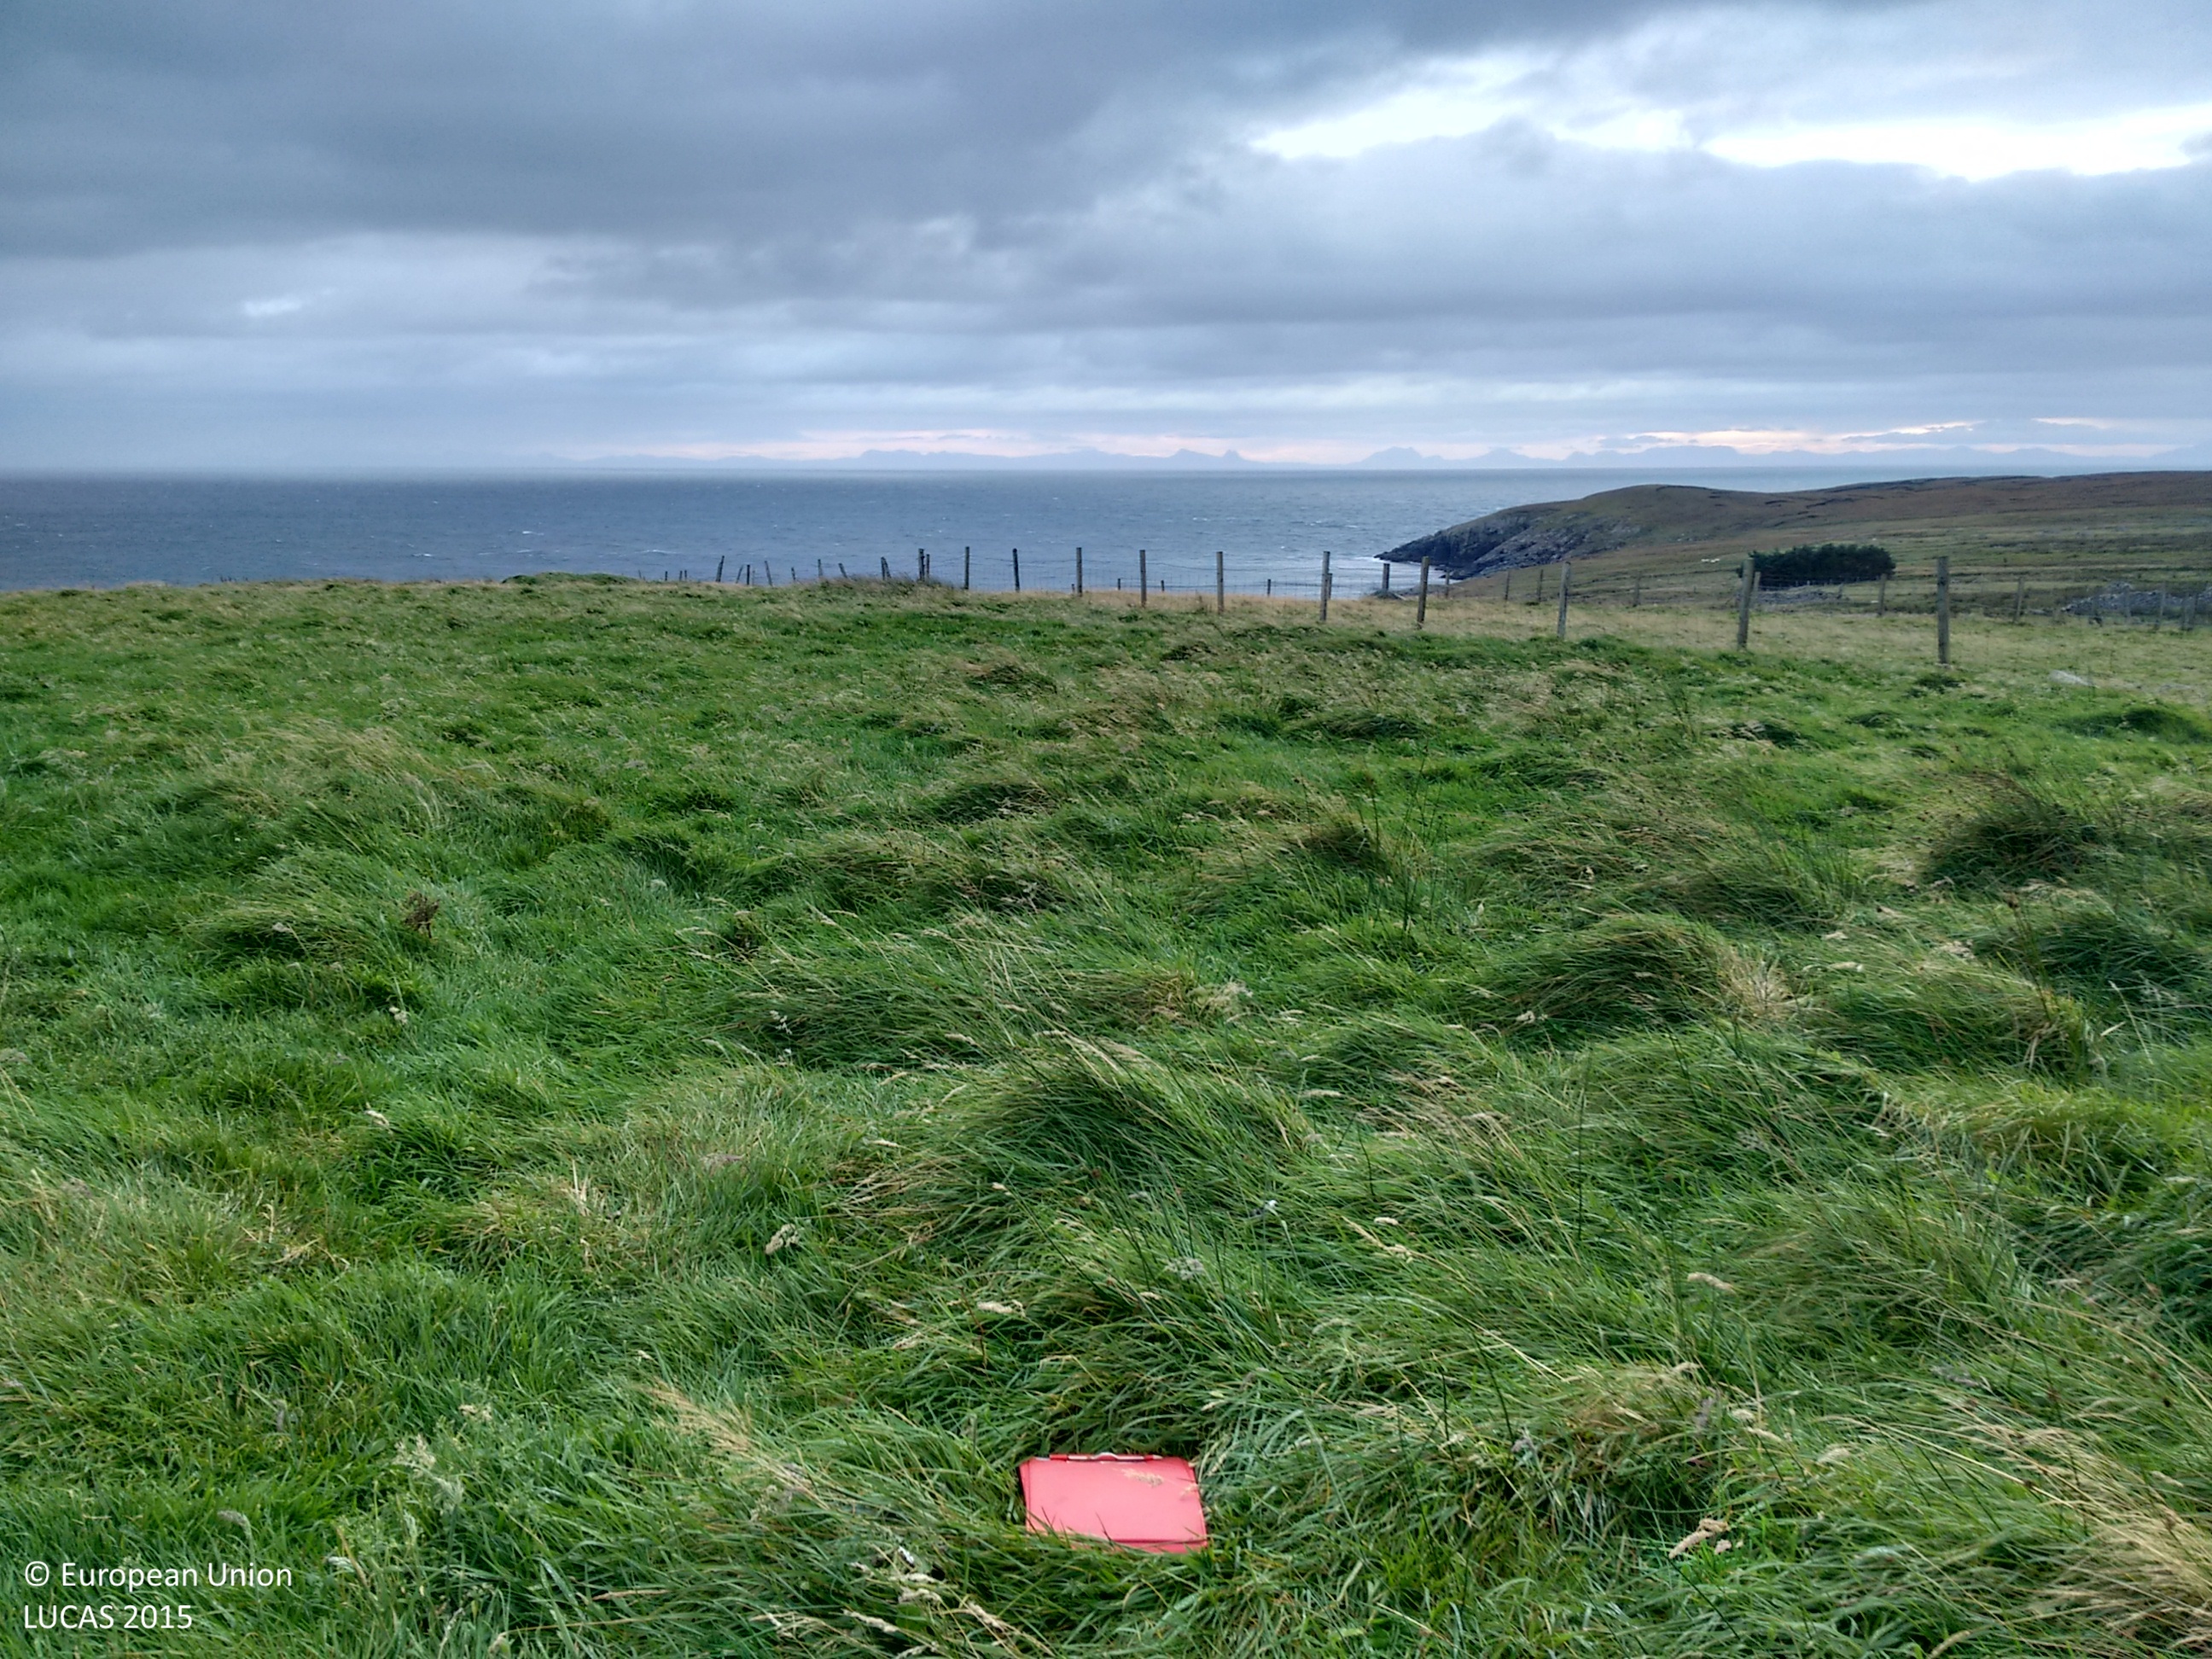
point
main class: Grassland
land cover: Grassland without tree/shrub cover
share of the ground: > 75 %
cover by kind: herbaceous plants 100 %
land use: Agriculture (excluding fallow land and kitchen gardens)
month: October
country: GB
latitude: 58.2442
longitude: -6.1585
